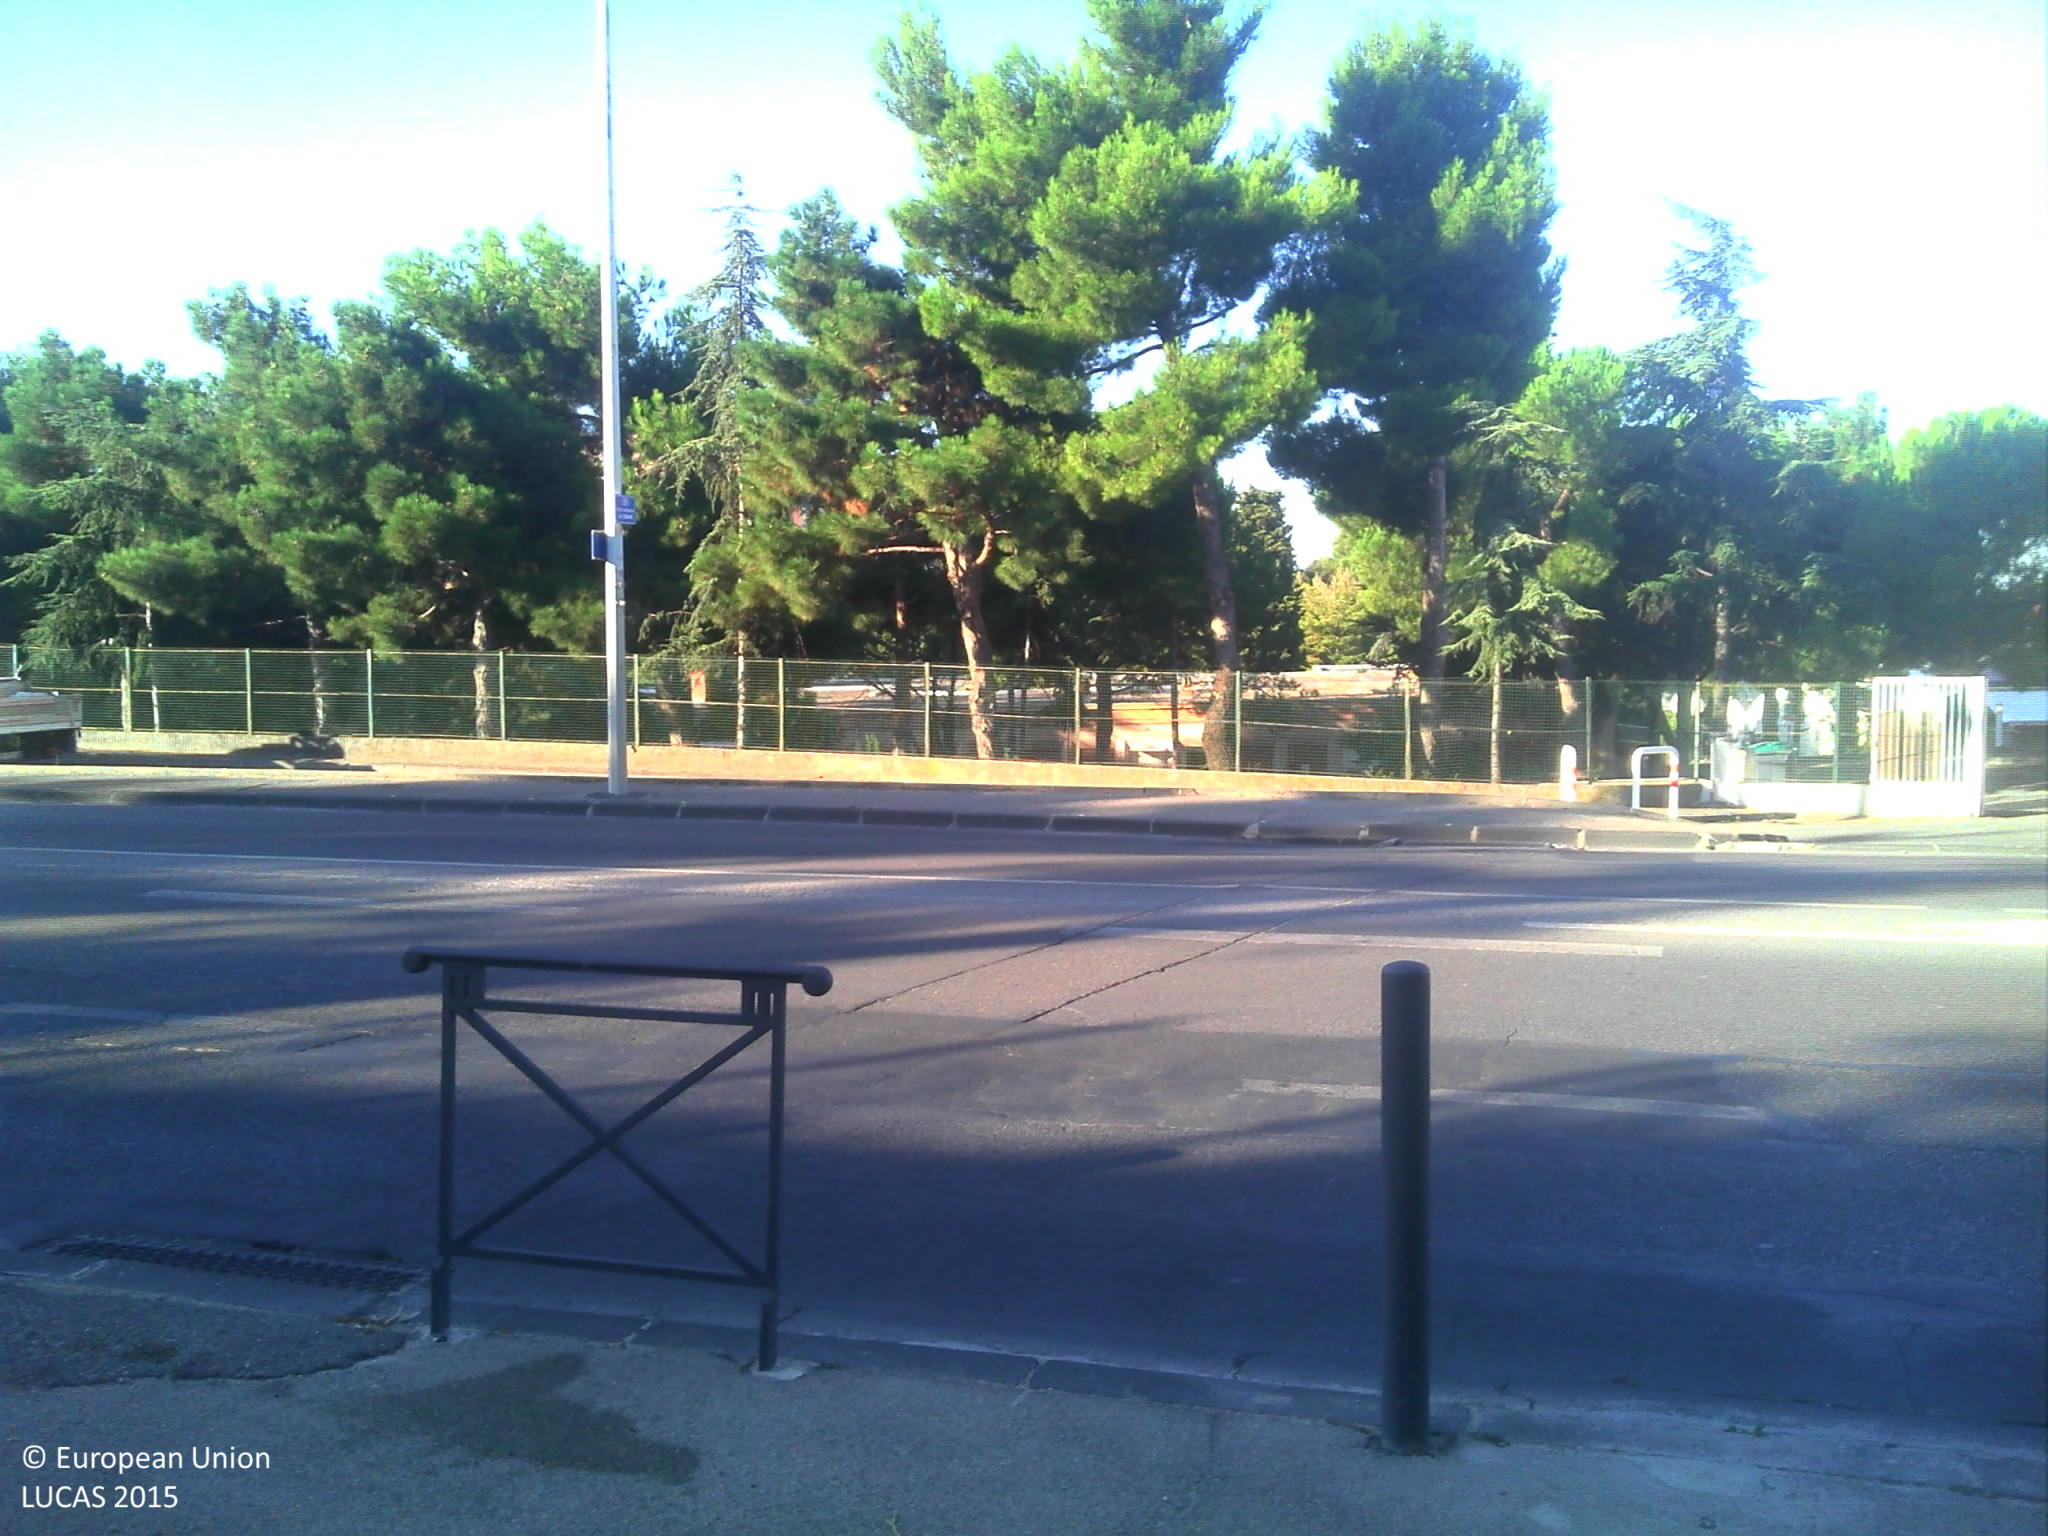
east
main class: Grassland
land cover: Spontaneously vegetated surfaces
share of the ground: > 75 %
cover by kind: consolidated bare surface 70 %, herbaceous plants 30 %
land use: Railway transport
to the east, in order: Spontaneously vegetated surfaces; Railways; Grassland with sparse tree/shrub cover; Inland fresh water bodies; Grassland without tree/shrub cover; Fences; Grassland with sparse tree/shrub cover; Artificial constructions in urban areas
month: August
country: FR
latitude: 43.3444
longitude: 5.3843
